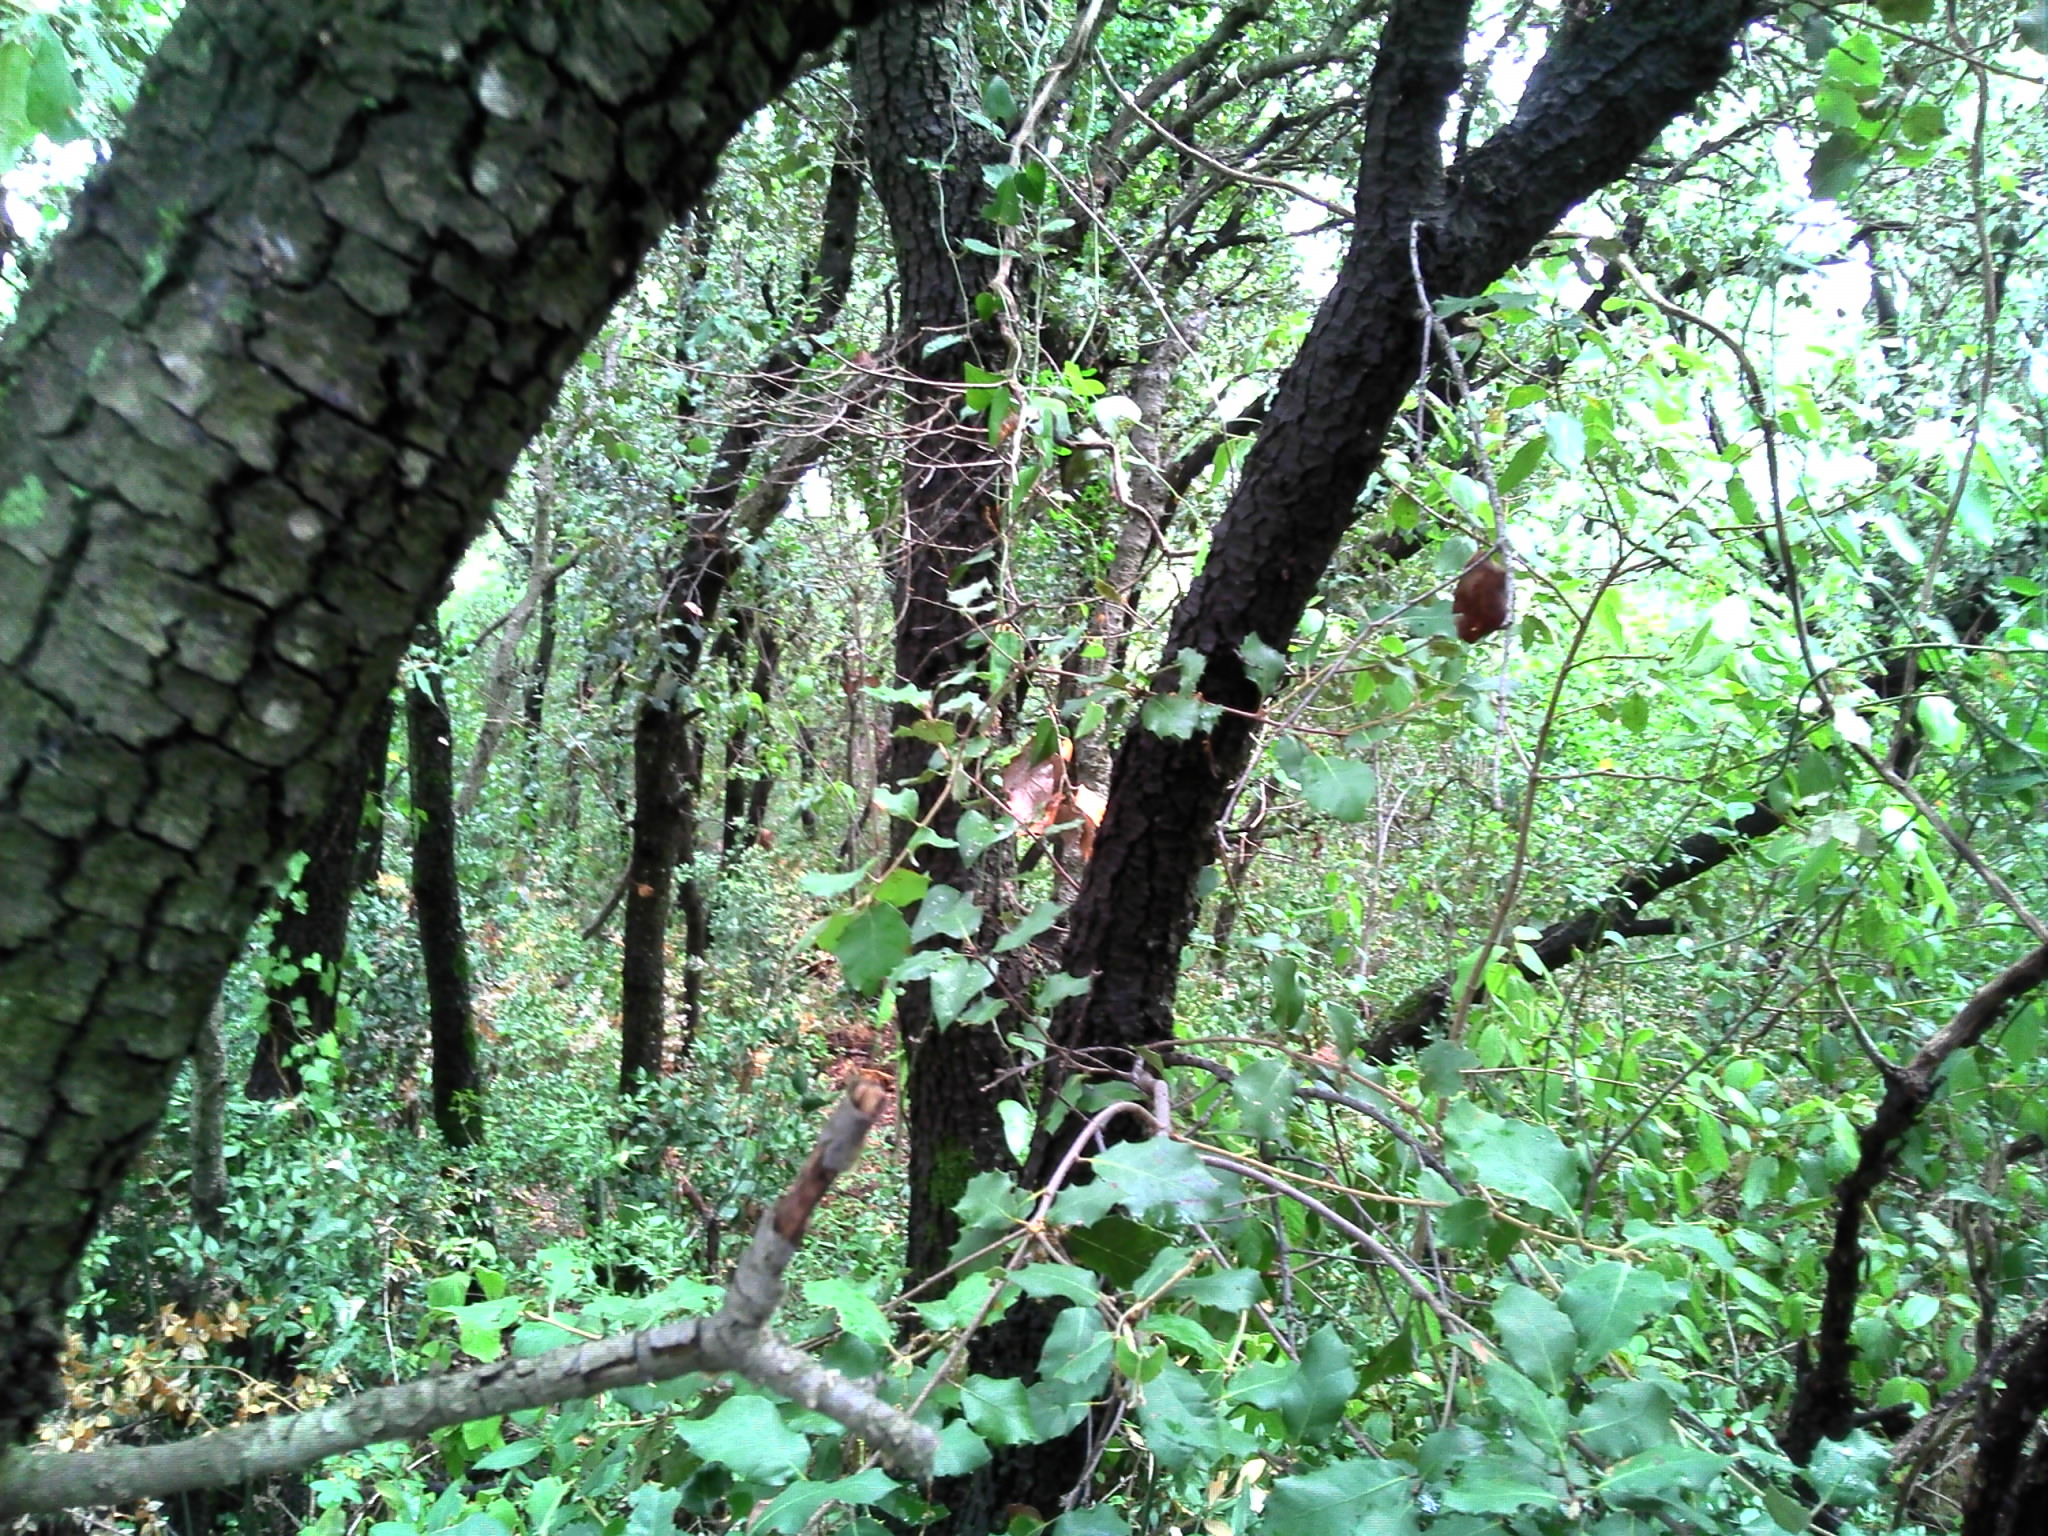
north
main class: Woodland
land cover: Broadleaved woodland
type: broadleaved evergreen forest
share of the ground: > 75 %
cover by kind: broadleaved forest trees 60 %, consolidated bare surface 20 %, shrubs 10 %, herbaceous plants 10 %
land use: Semi-natural and natural areas not in use
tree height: > 5 m
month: August
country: FR
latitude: 44.1220
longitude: 4.6470
